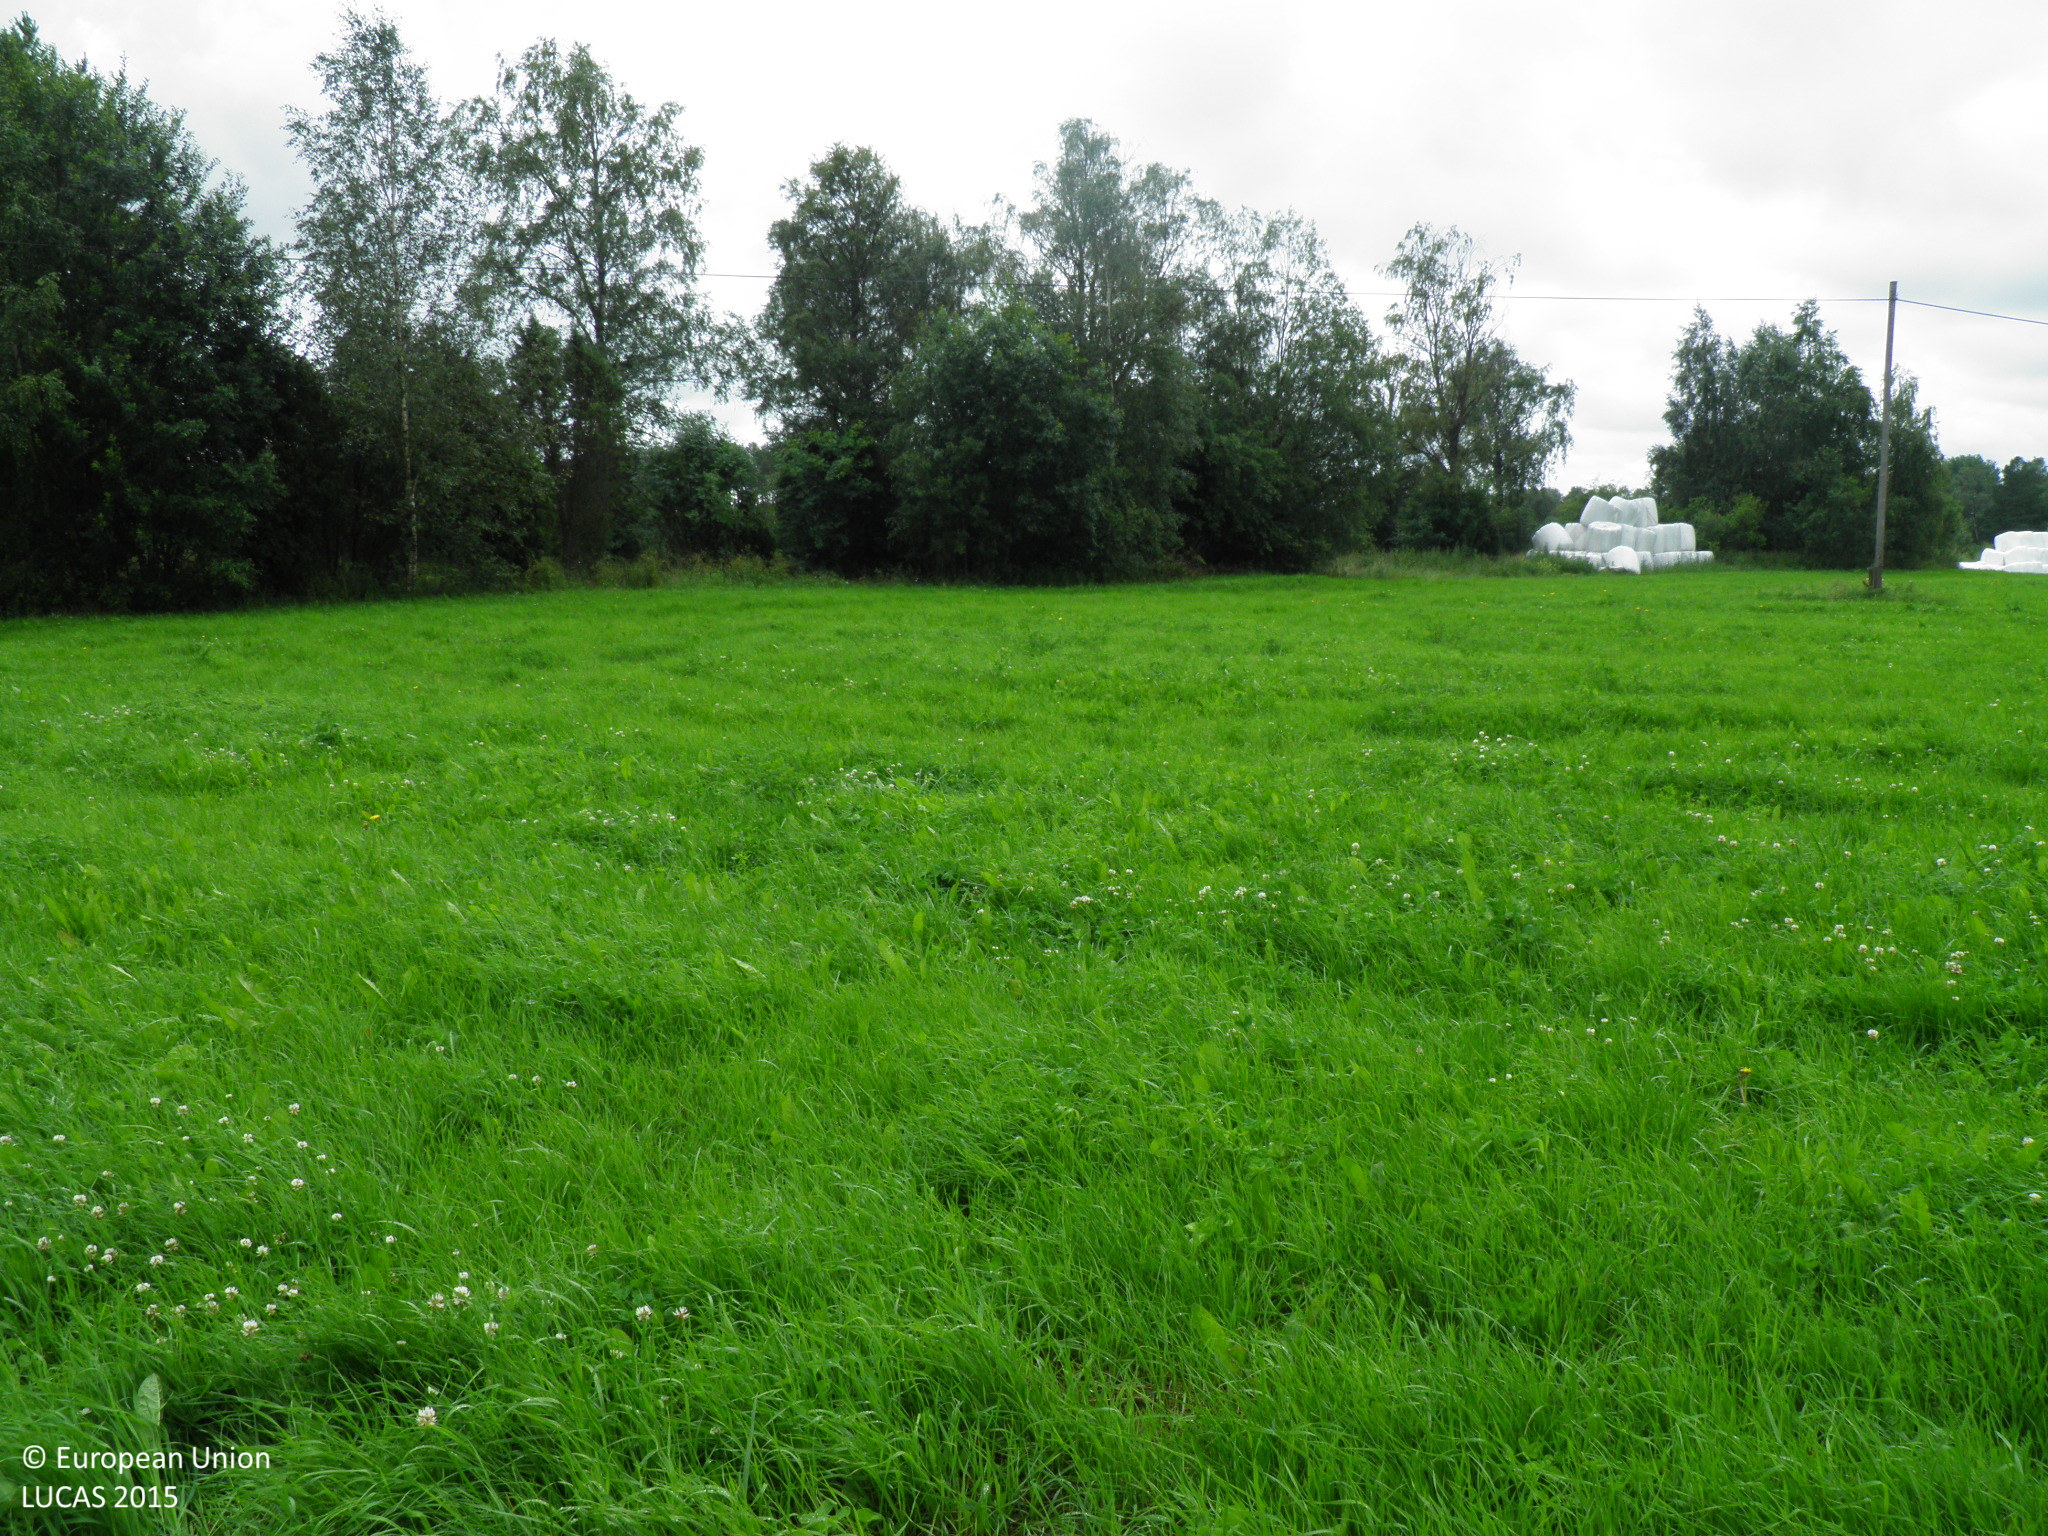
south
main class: Cropland
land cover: Temporary grasslands
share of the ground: > 75 %
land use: Agriculture (excluding fallow land and kitchen gardens)
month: July
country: FI
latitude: 60.6512
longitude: 21.5614
